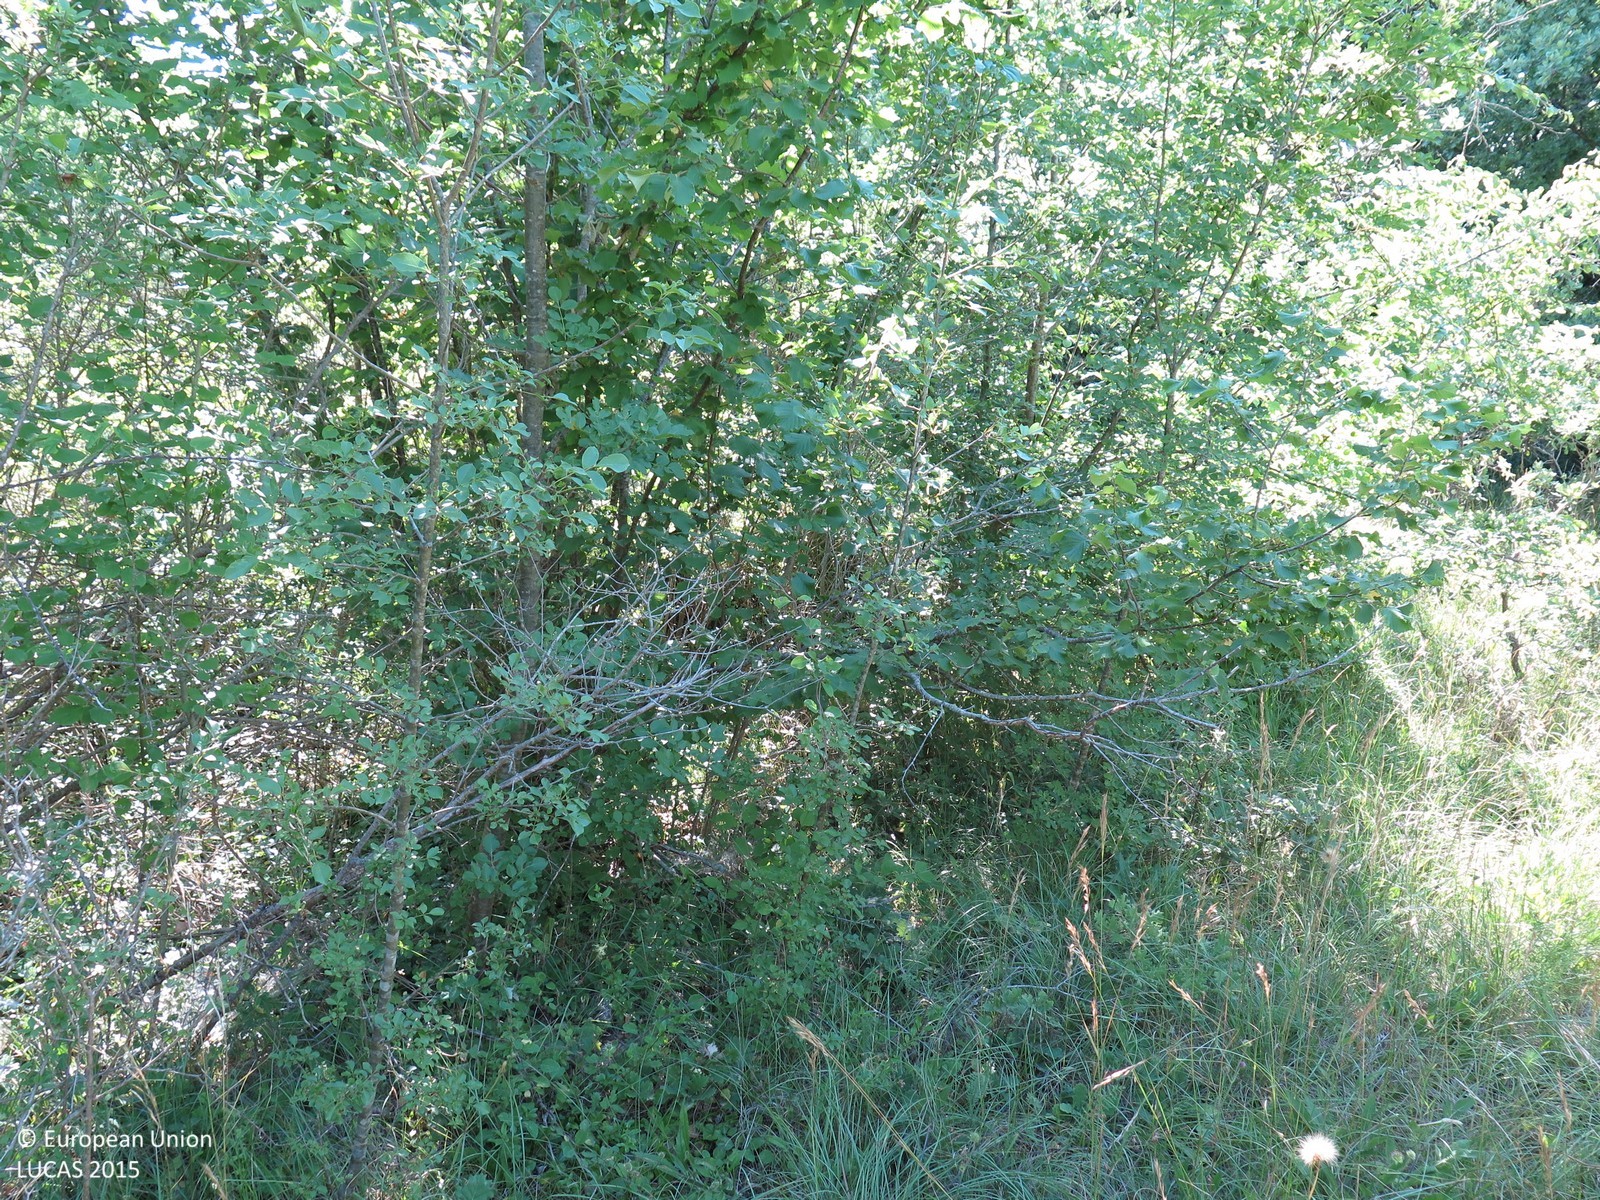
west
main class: Woodland
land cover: Broadleaved woodland
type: mesophytic deciduous forest
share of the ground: > 75 %
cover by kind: broadleaved forest trees 90 %, shrubs 5 %, herbaceous plants 5 %
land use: Semi-natural and natural areas not in use
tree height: > 5 m
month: June
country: HR
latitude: 45.2393
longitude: 13.7529
